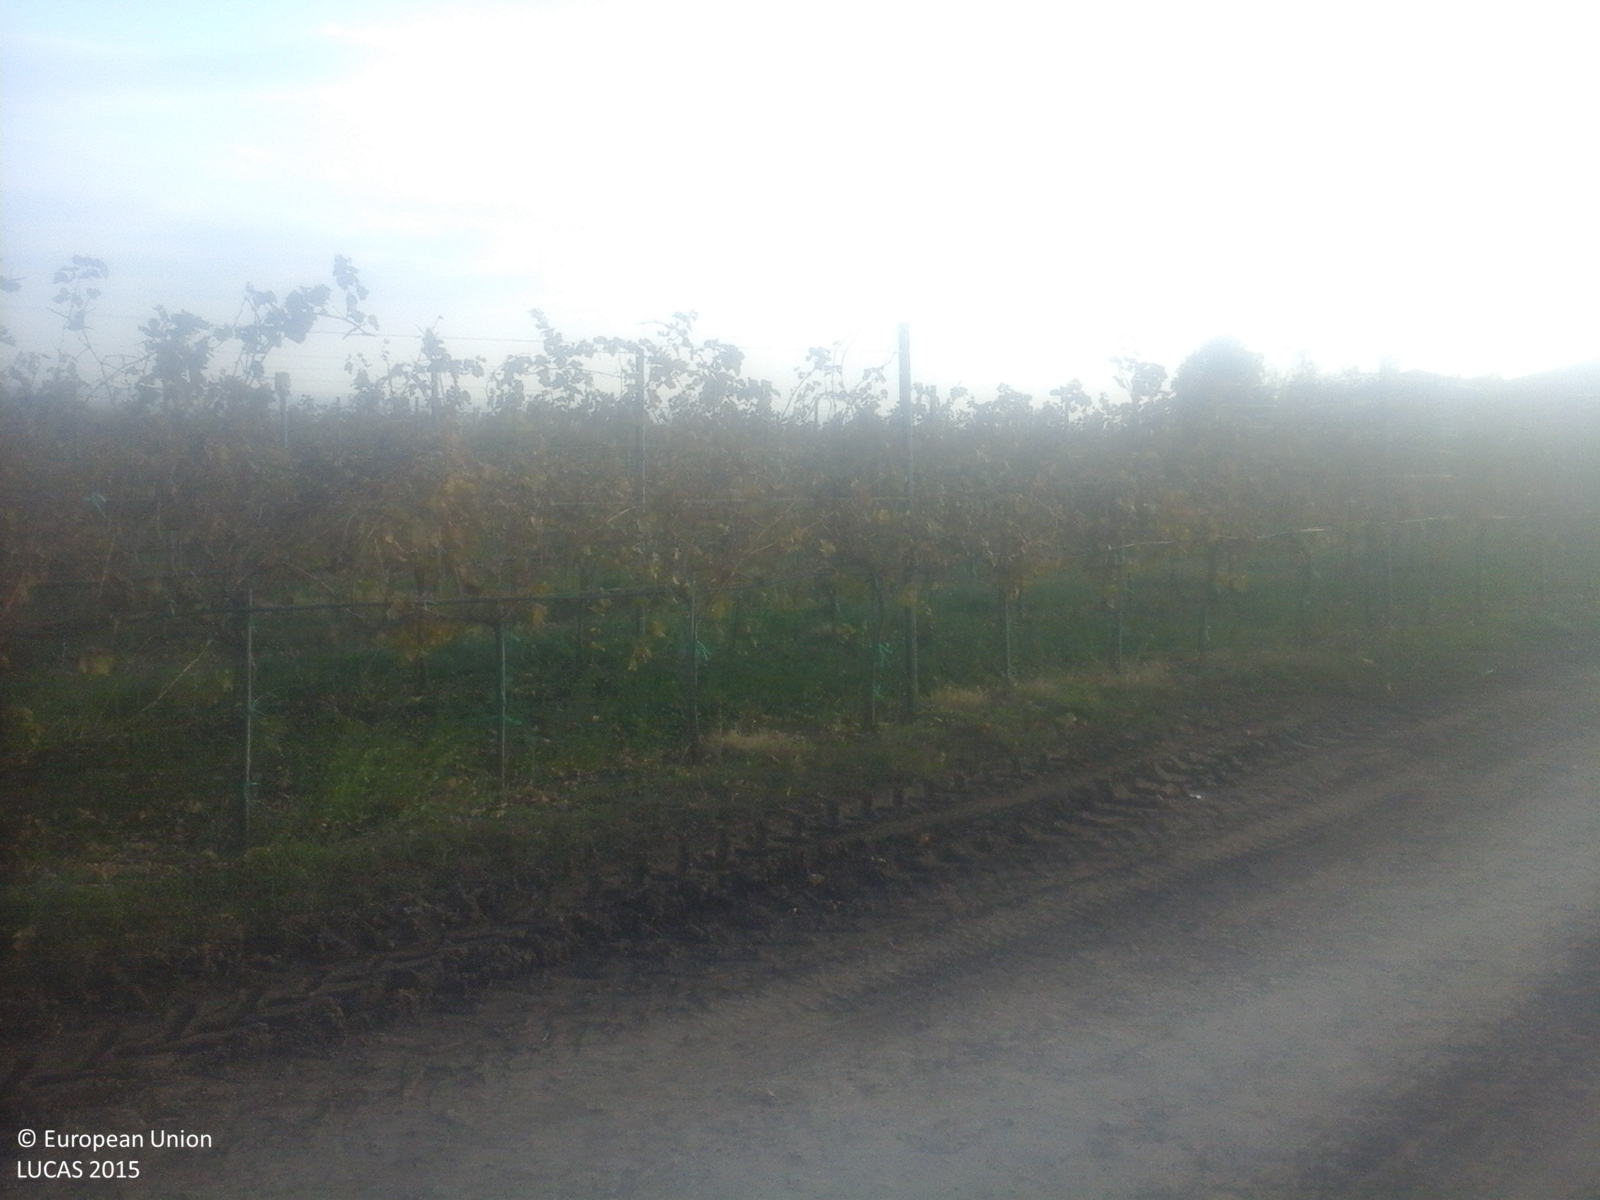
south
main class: Cropland
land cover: Vineyards
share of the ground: > 75 %
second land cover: Other bare soil
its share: > 75 %
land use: Agriculture (excluding fallow land and kitchen gardens)
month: October
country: RO
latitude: 45.3849
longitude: 26.9833
